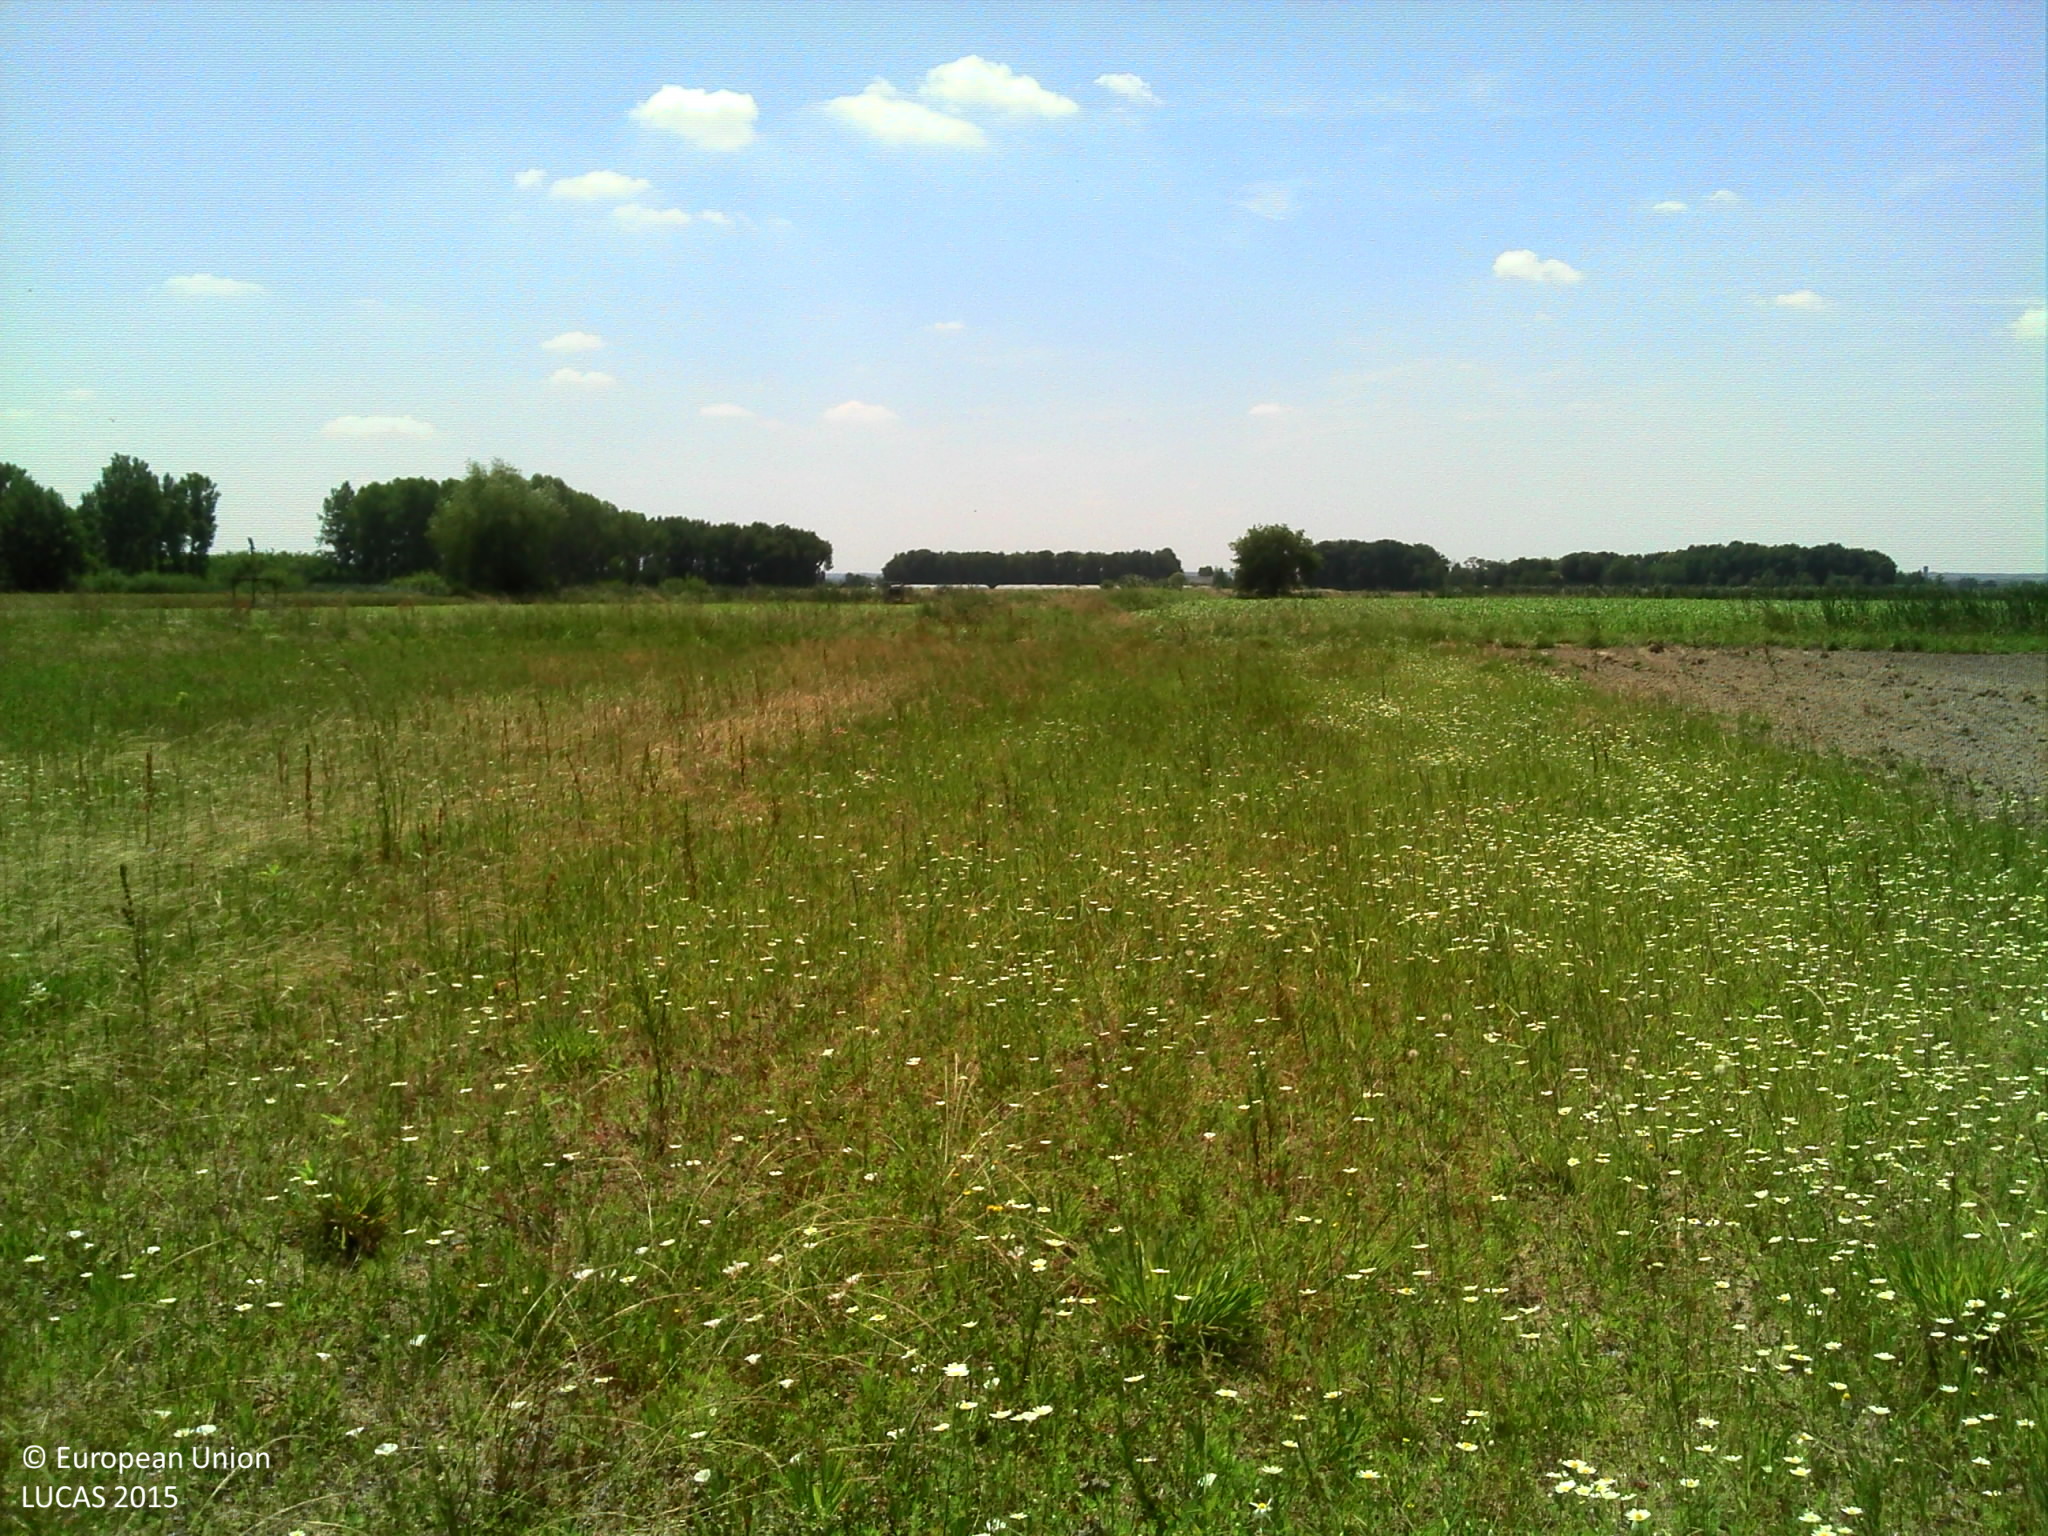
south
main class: Cropland
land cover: Temporary grasslands
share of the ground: > 75 %
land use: Agriculture (excluding fallow land and kitchen gardens)
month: June
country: FR
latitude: 47.3003
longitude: 0.0431
